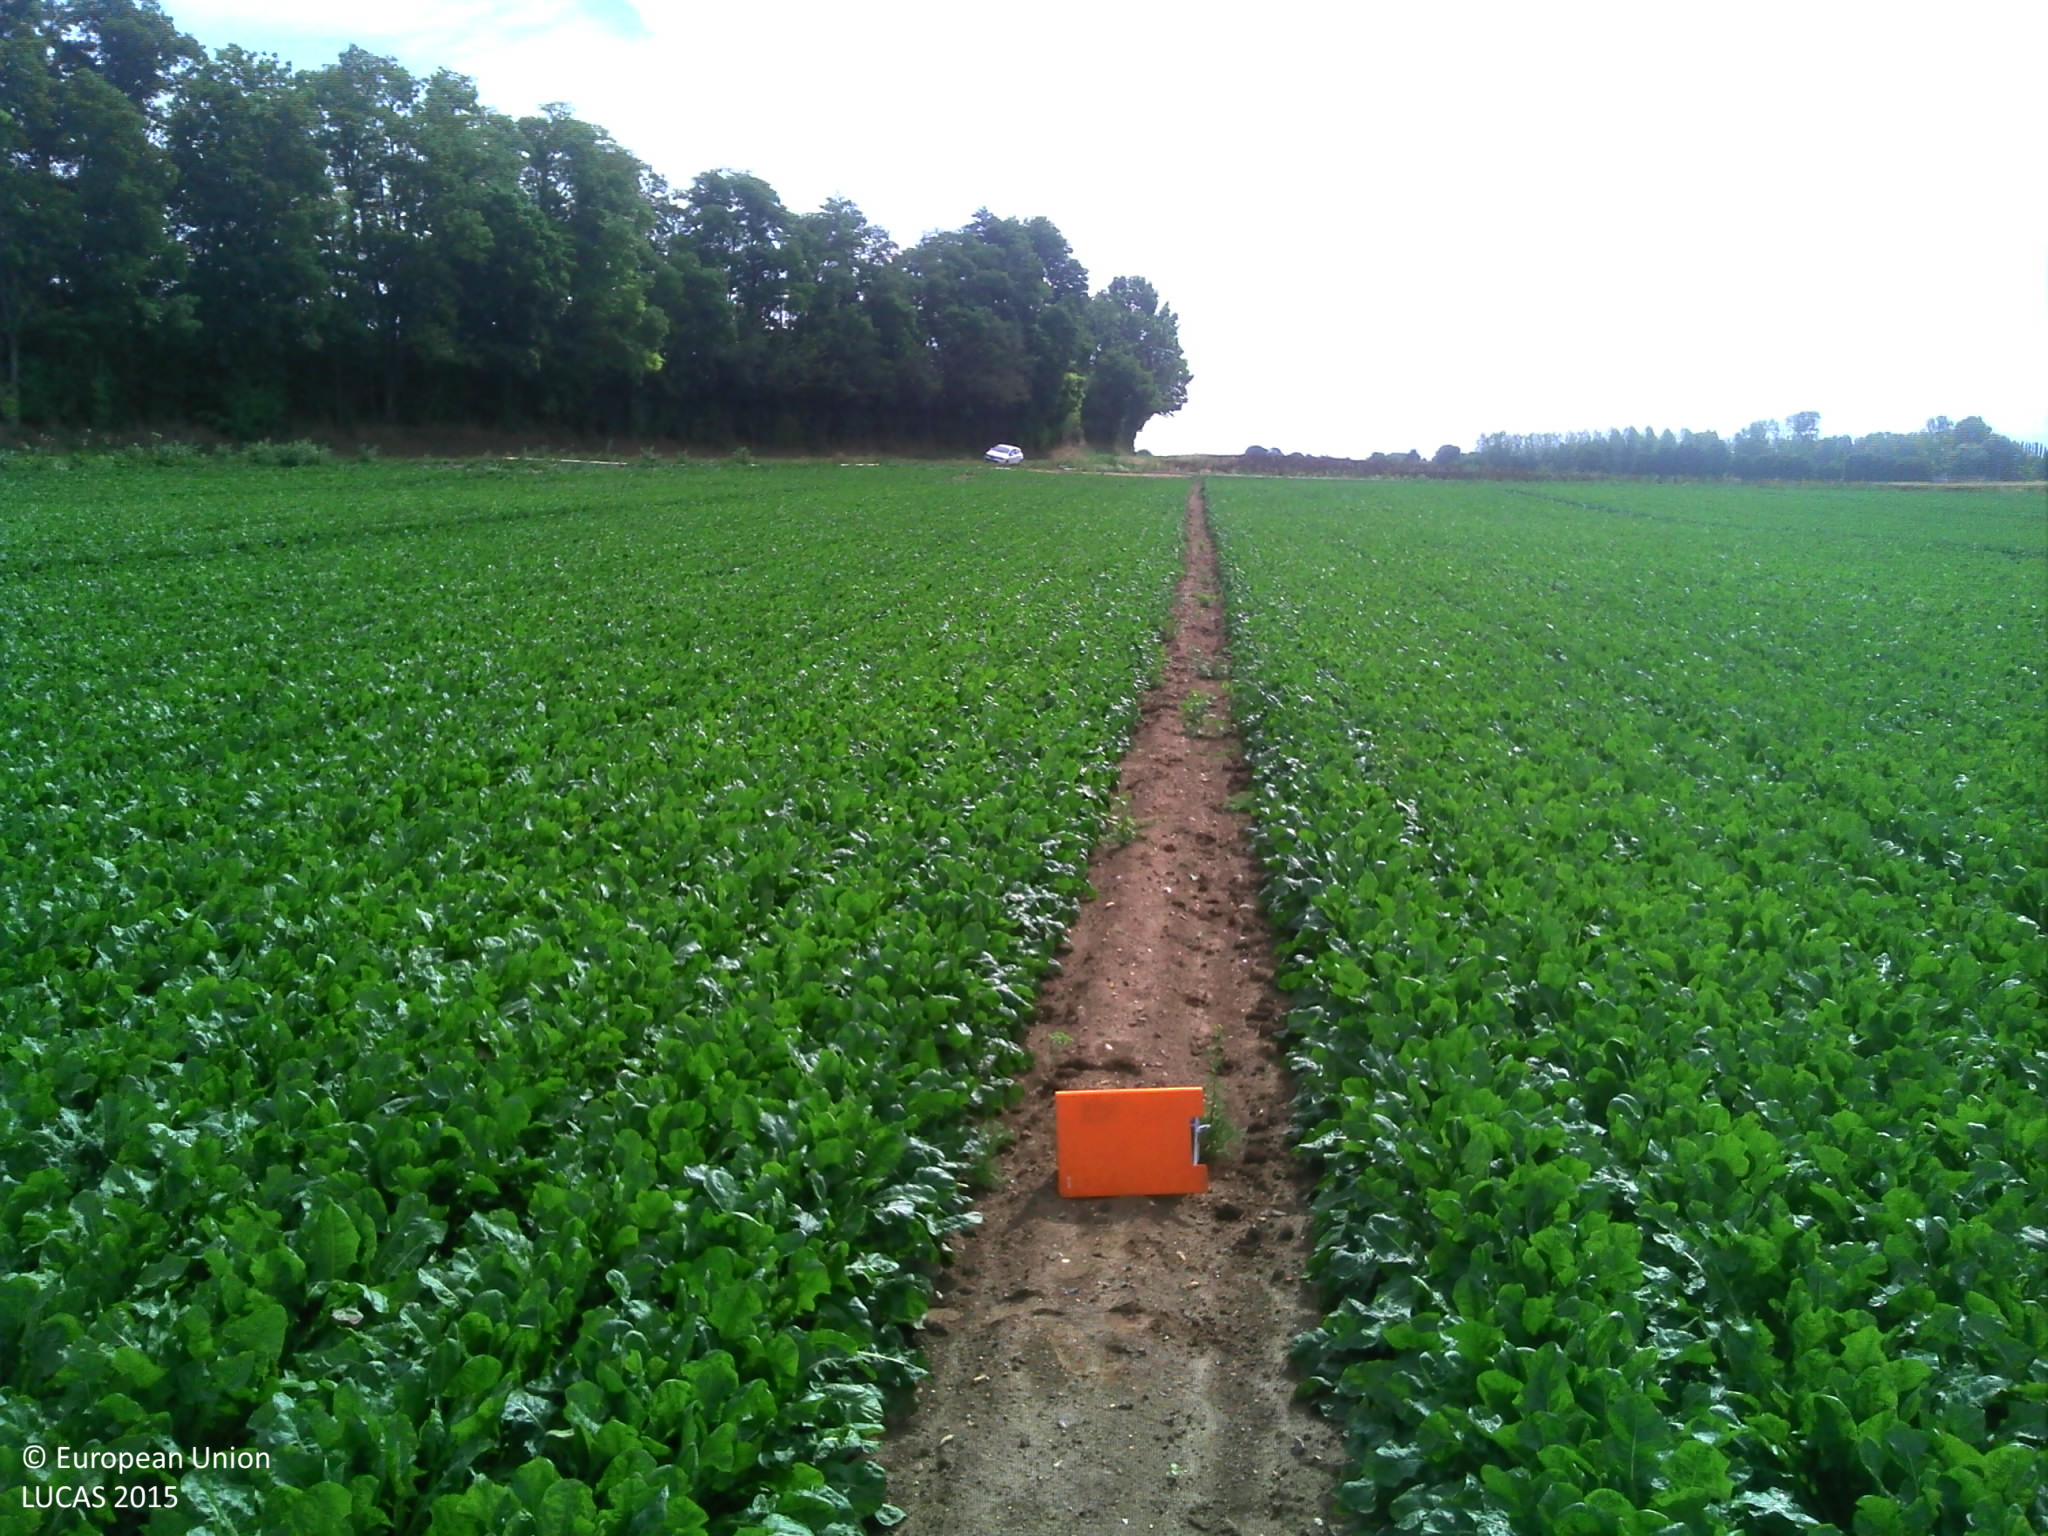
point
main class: Cropland
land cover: Sugar beet
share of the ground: > 75 %
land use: Agriculture (excluding fallow land and kitchen gardens)
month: July
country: FR
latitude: 49.6978
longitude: 3.6017
